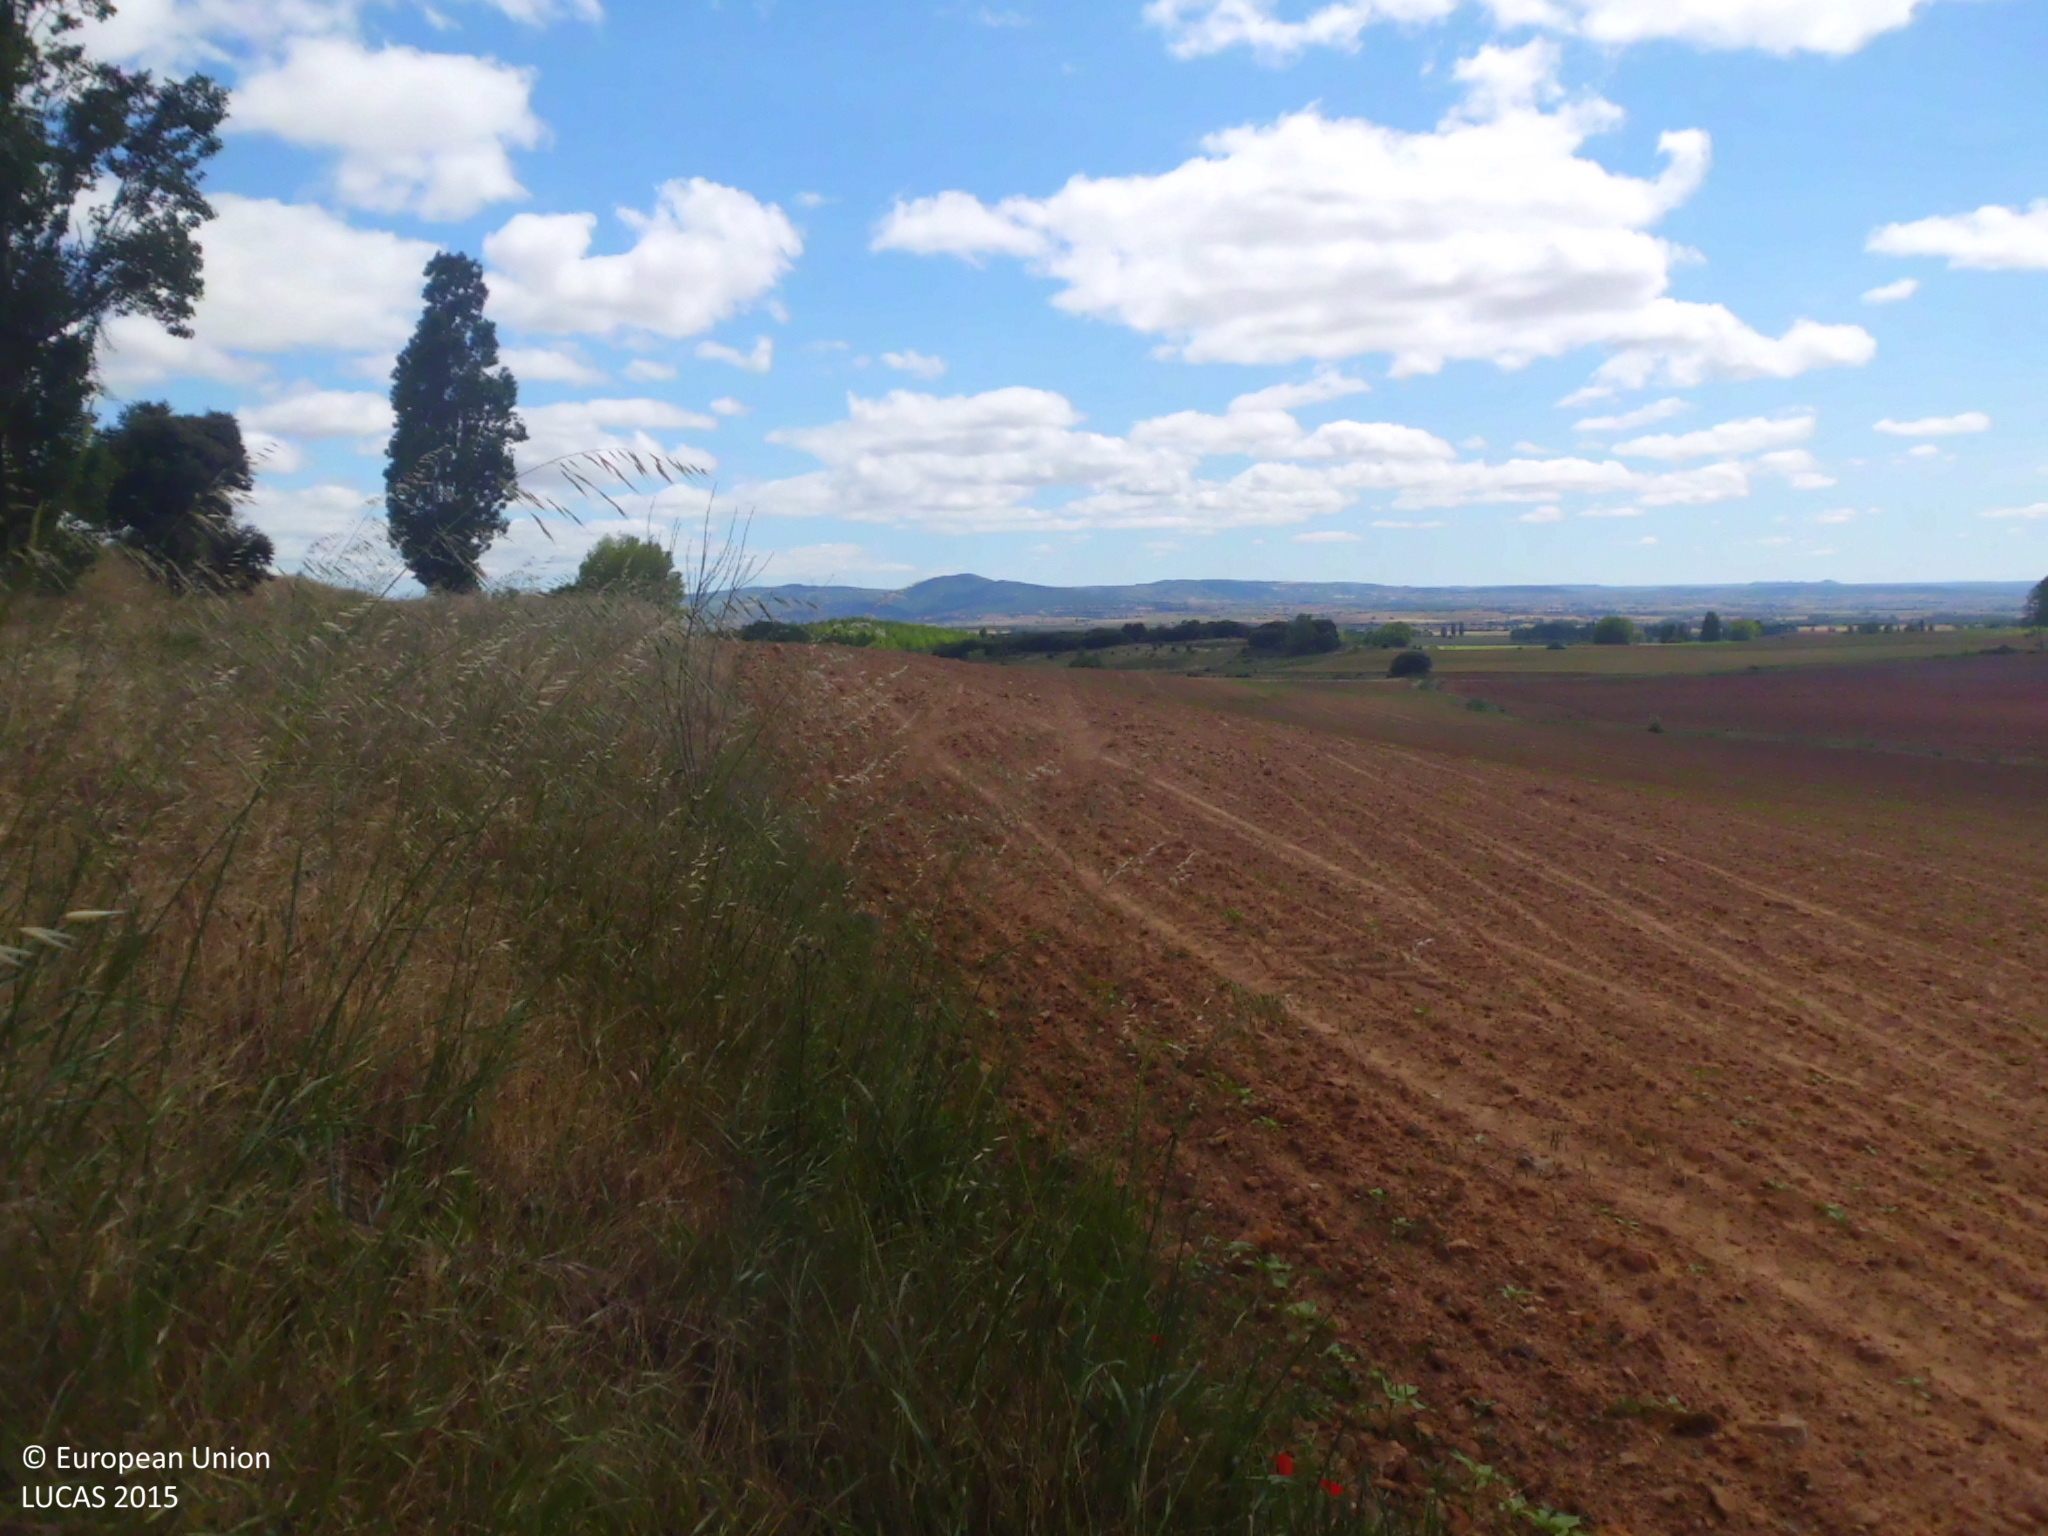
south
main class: Grassland
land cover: Grassland with sparse tree/shrub cover
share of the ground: > 75 %
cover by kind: herbaceous plants 80 %, consolidated bare surface 15 %, broadleaved forest trees 5 %
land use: Agriculture (excluding fallow land and kitchen gardens)
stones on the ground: < 10 %
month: June
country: ES
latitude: 42.6799
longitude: -3.3486
